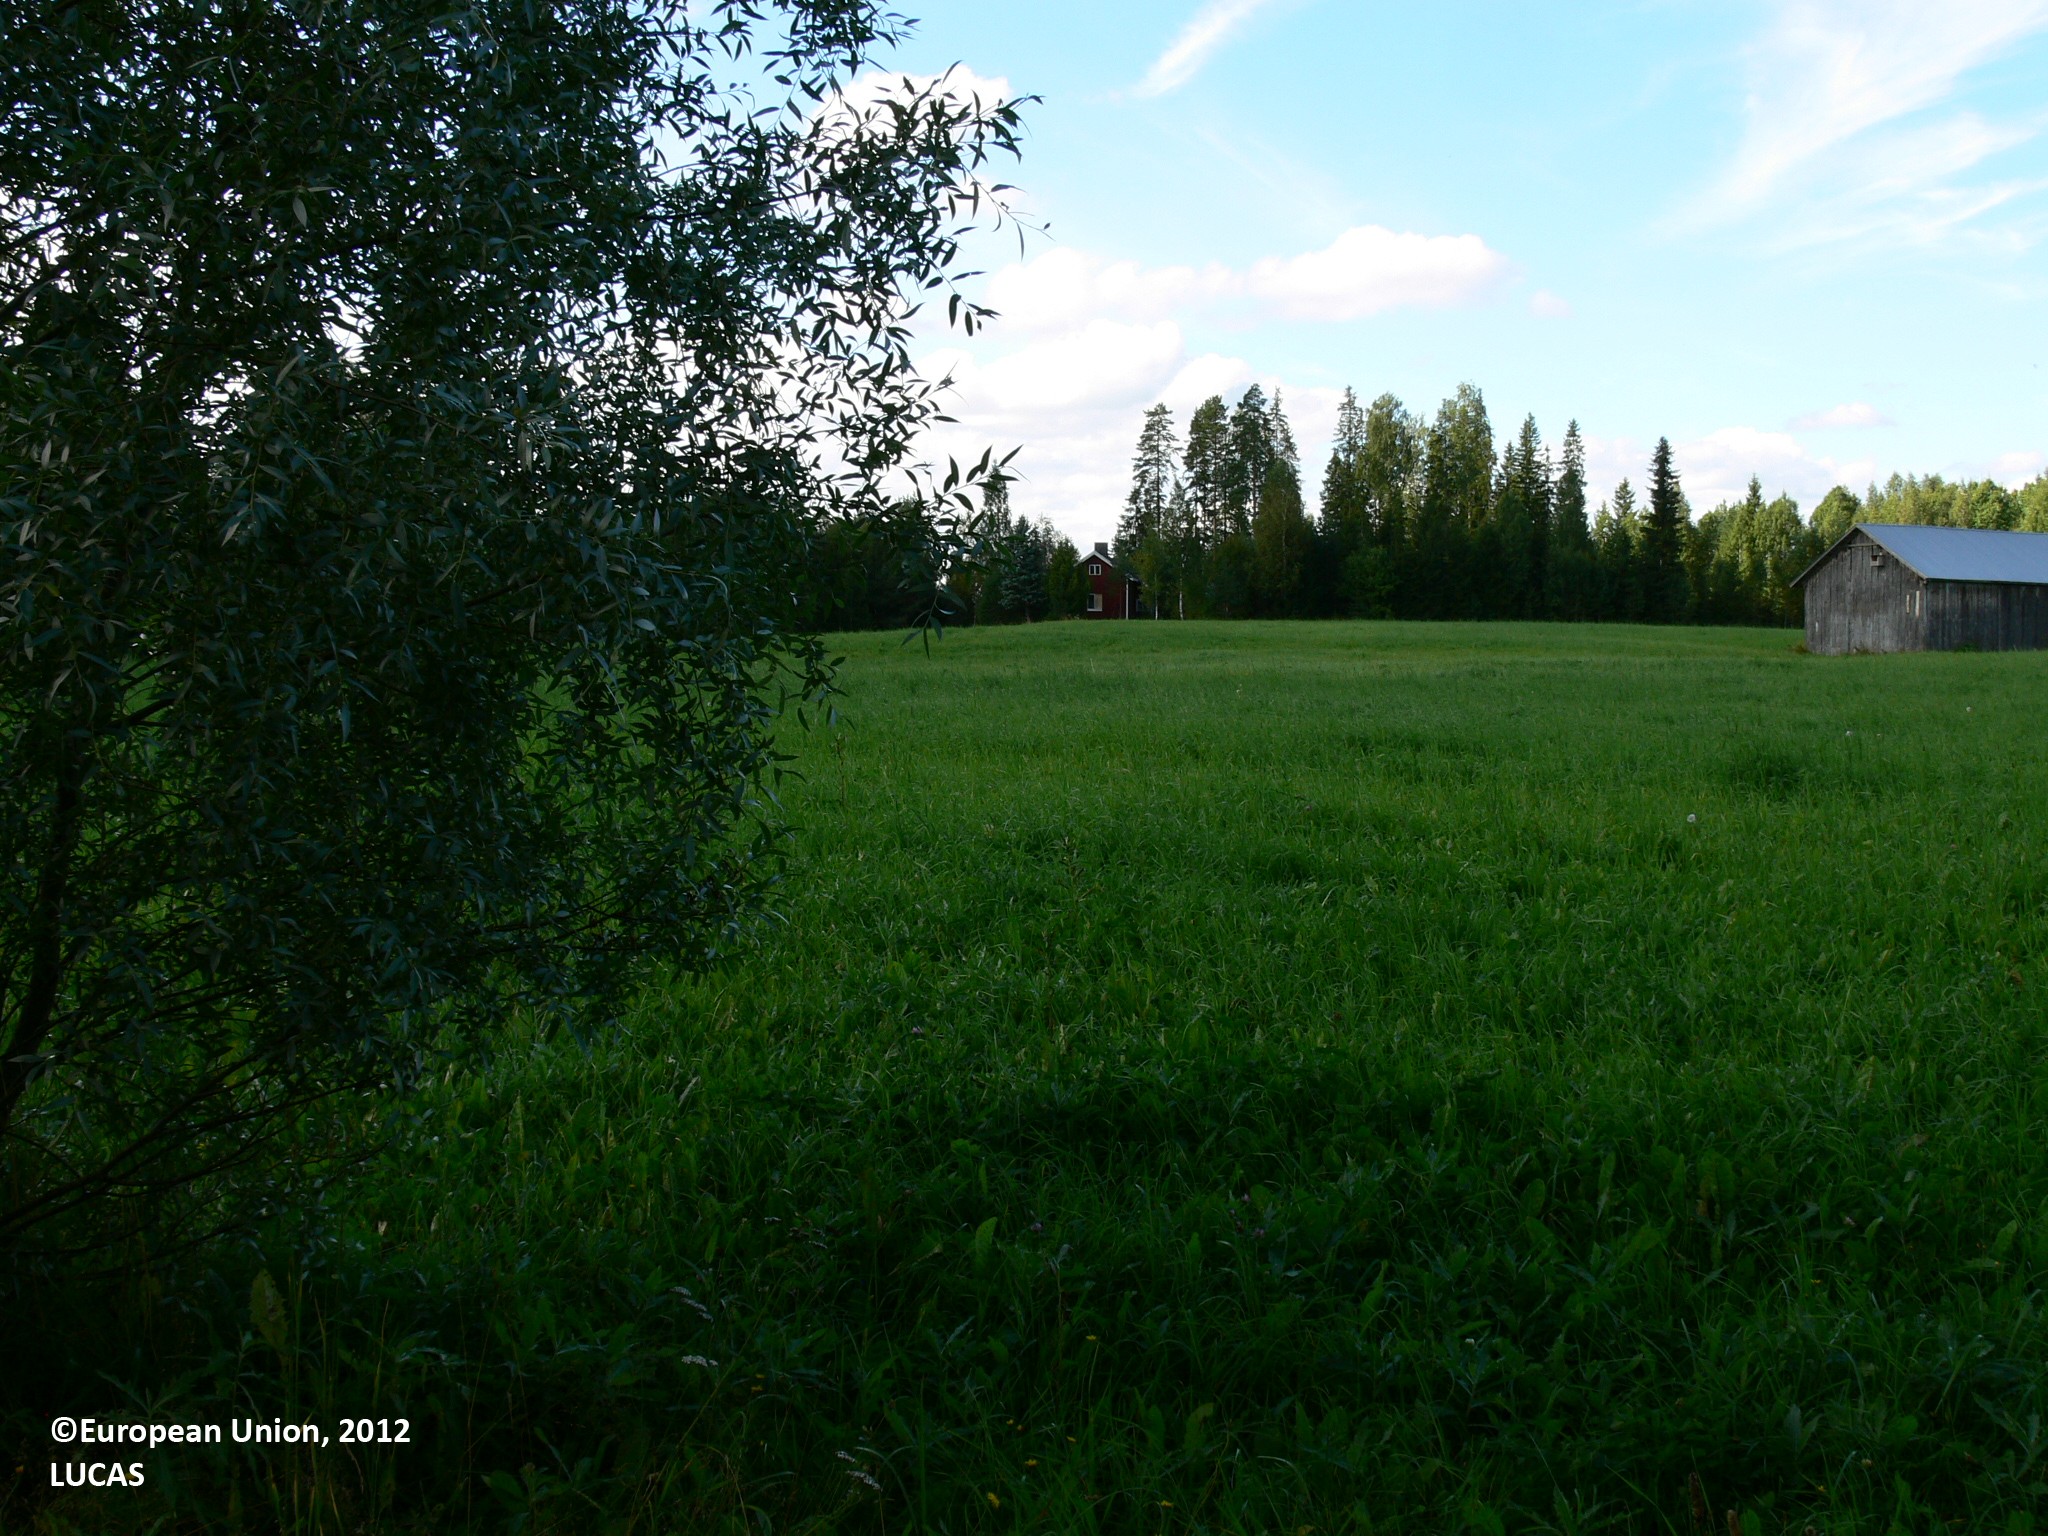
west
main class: Cropland
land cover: Temporary grasslands
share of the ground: > 75 %
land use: Agriculture (excluding fallow land and kitchen gardens)
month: August
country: FI
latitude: 62.0724
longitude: 30.1179
